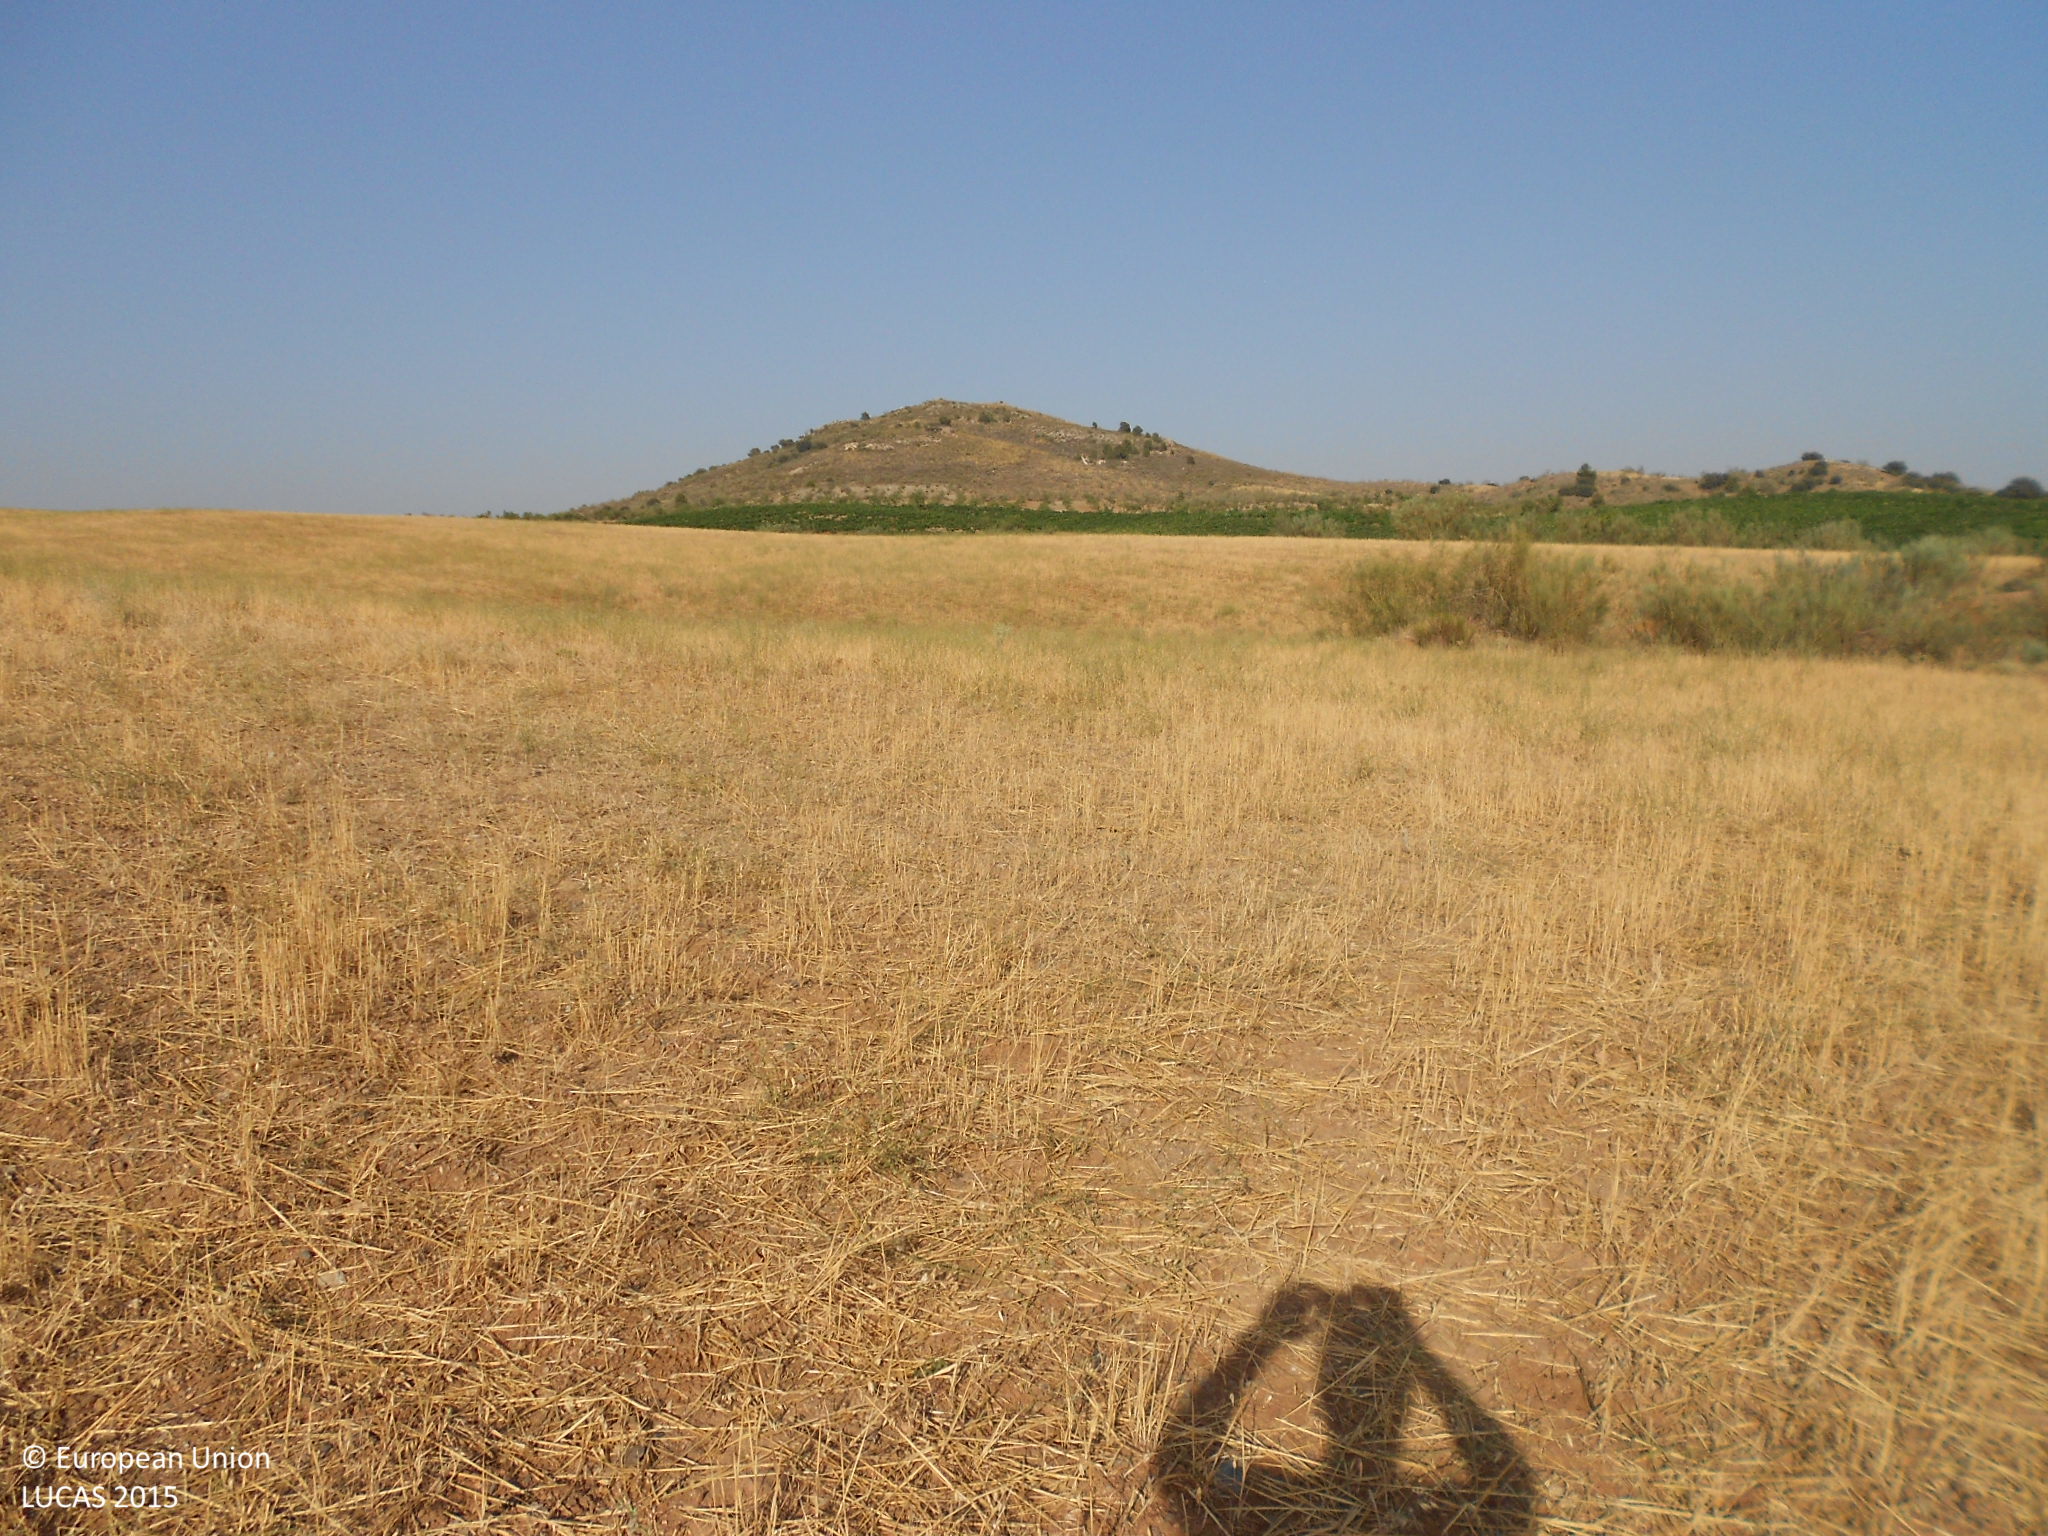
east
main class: Grassland
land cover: Spontaneously vegetated surfaces
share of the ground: > 75 %
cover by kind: herbaceous plants 85 %, consolidated bare surface 15 %
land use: Fallow land
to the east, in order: Spontaneously vegetated surfaces; Grass margins; Vineyards; Tracks; Vineyards
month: July
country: ES
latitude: 37.4566
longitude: -2.3171
